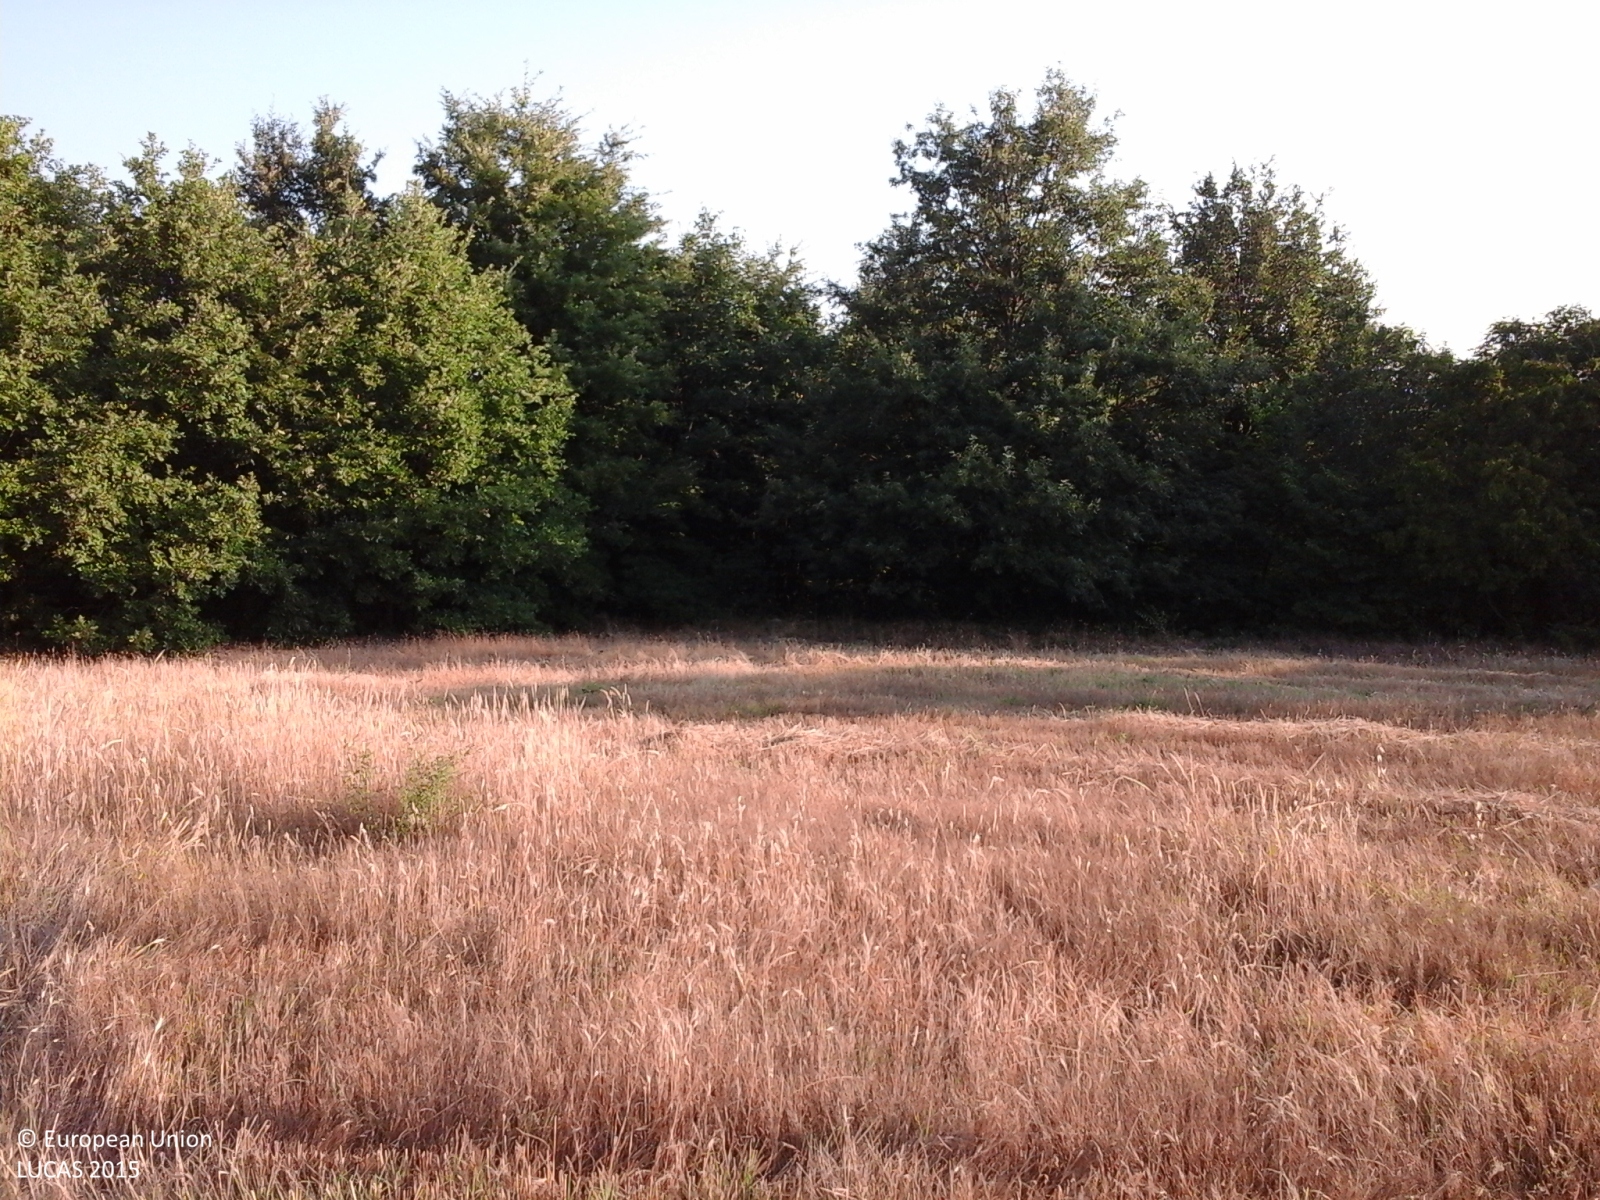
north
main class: Cropland
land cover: Durum wheat
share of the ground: > 75 %
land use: Agriculture (excluding fallow land and kitchen gardens)
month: July
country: IT
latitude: 41.5487
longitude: 14.7190
